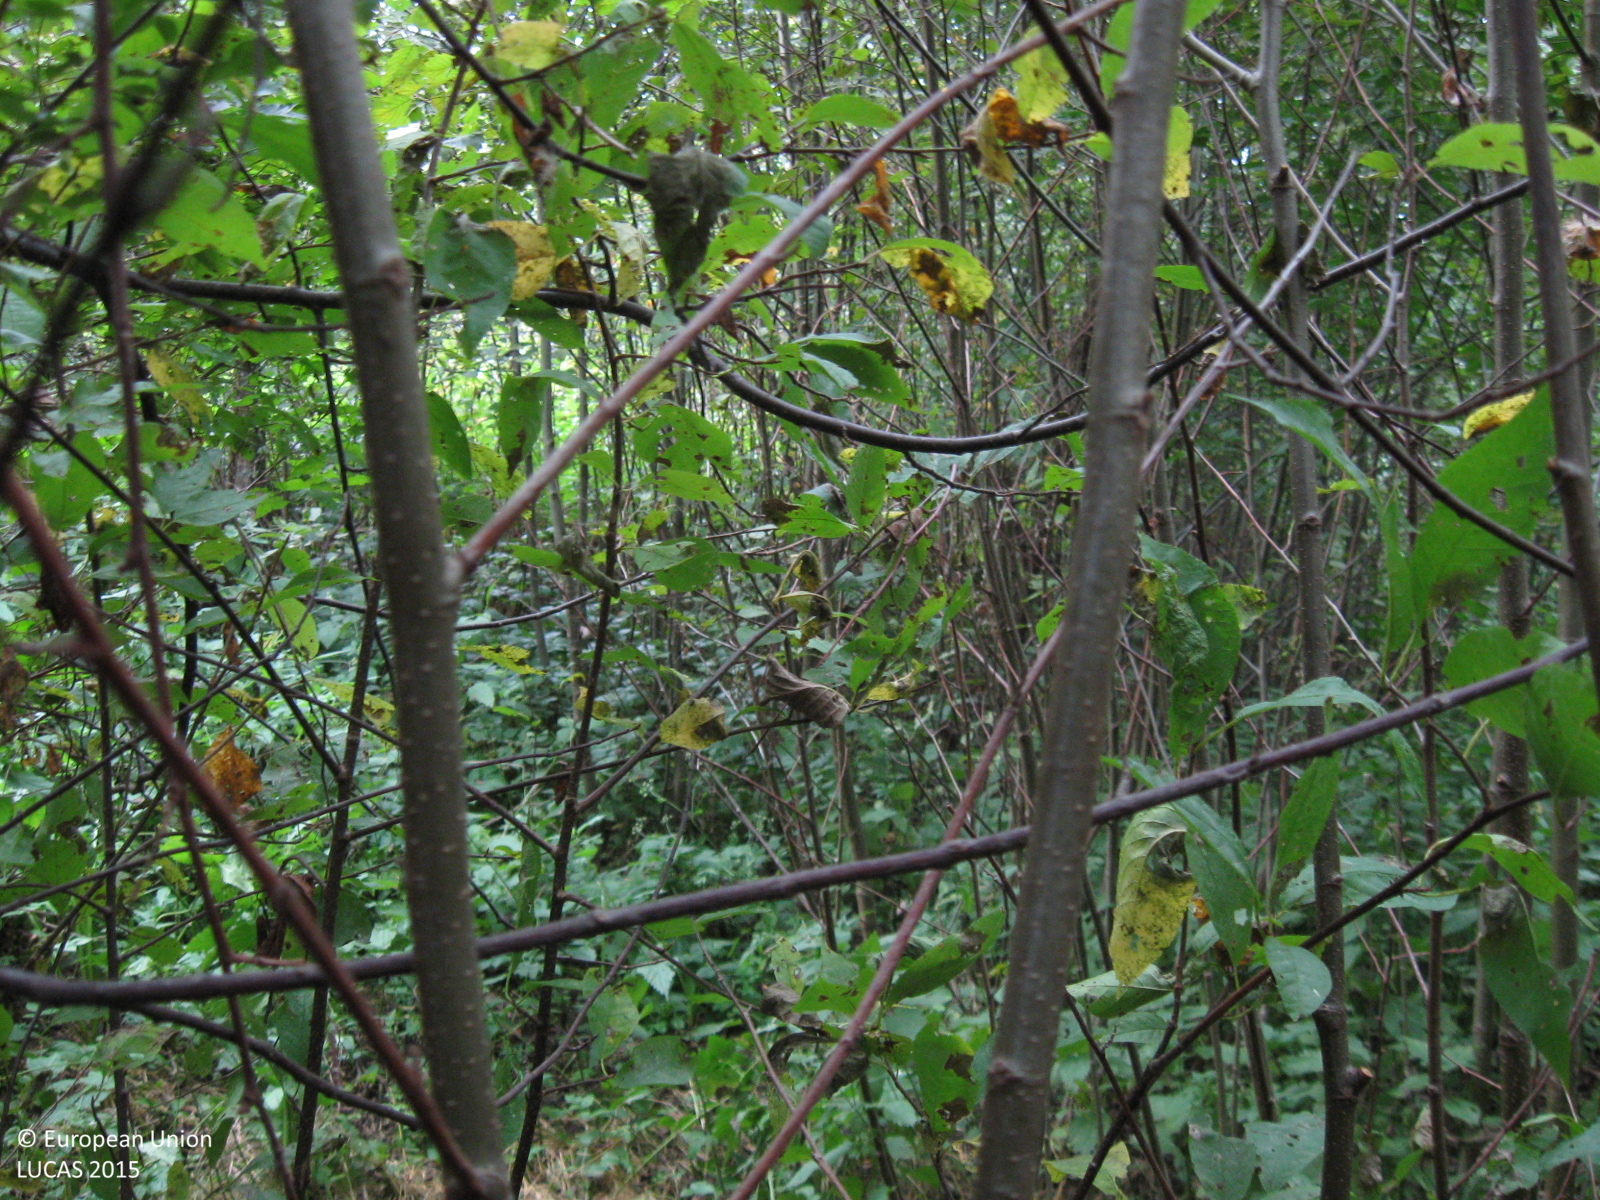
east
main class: Woodland
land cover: Broadleaved woodland
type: non-riverine alder, birch or aspen forest
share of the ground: > 75 %
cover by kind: broadleaved forest trees 90 %, herbaceous plants 10 %
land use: Forestry
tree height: > 5 m
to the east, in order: Broadleaved woodland; Tracks; Broadleaved woodland; Fences; Shrubland with sparse tree cover; Pine dominated coniferous woodland
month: September
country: LT
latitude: 55.2753
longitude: 23.4428
